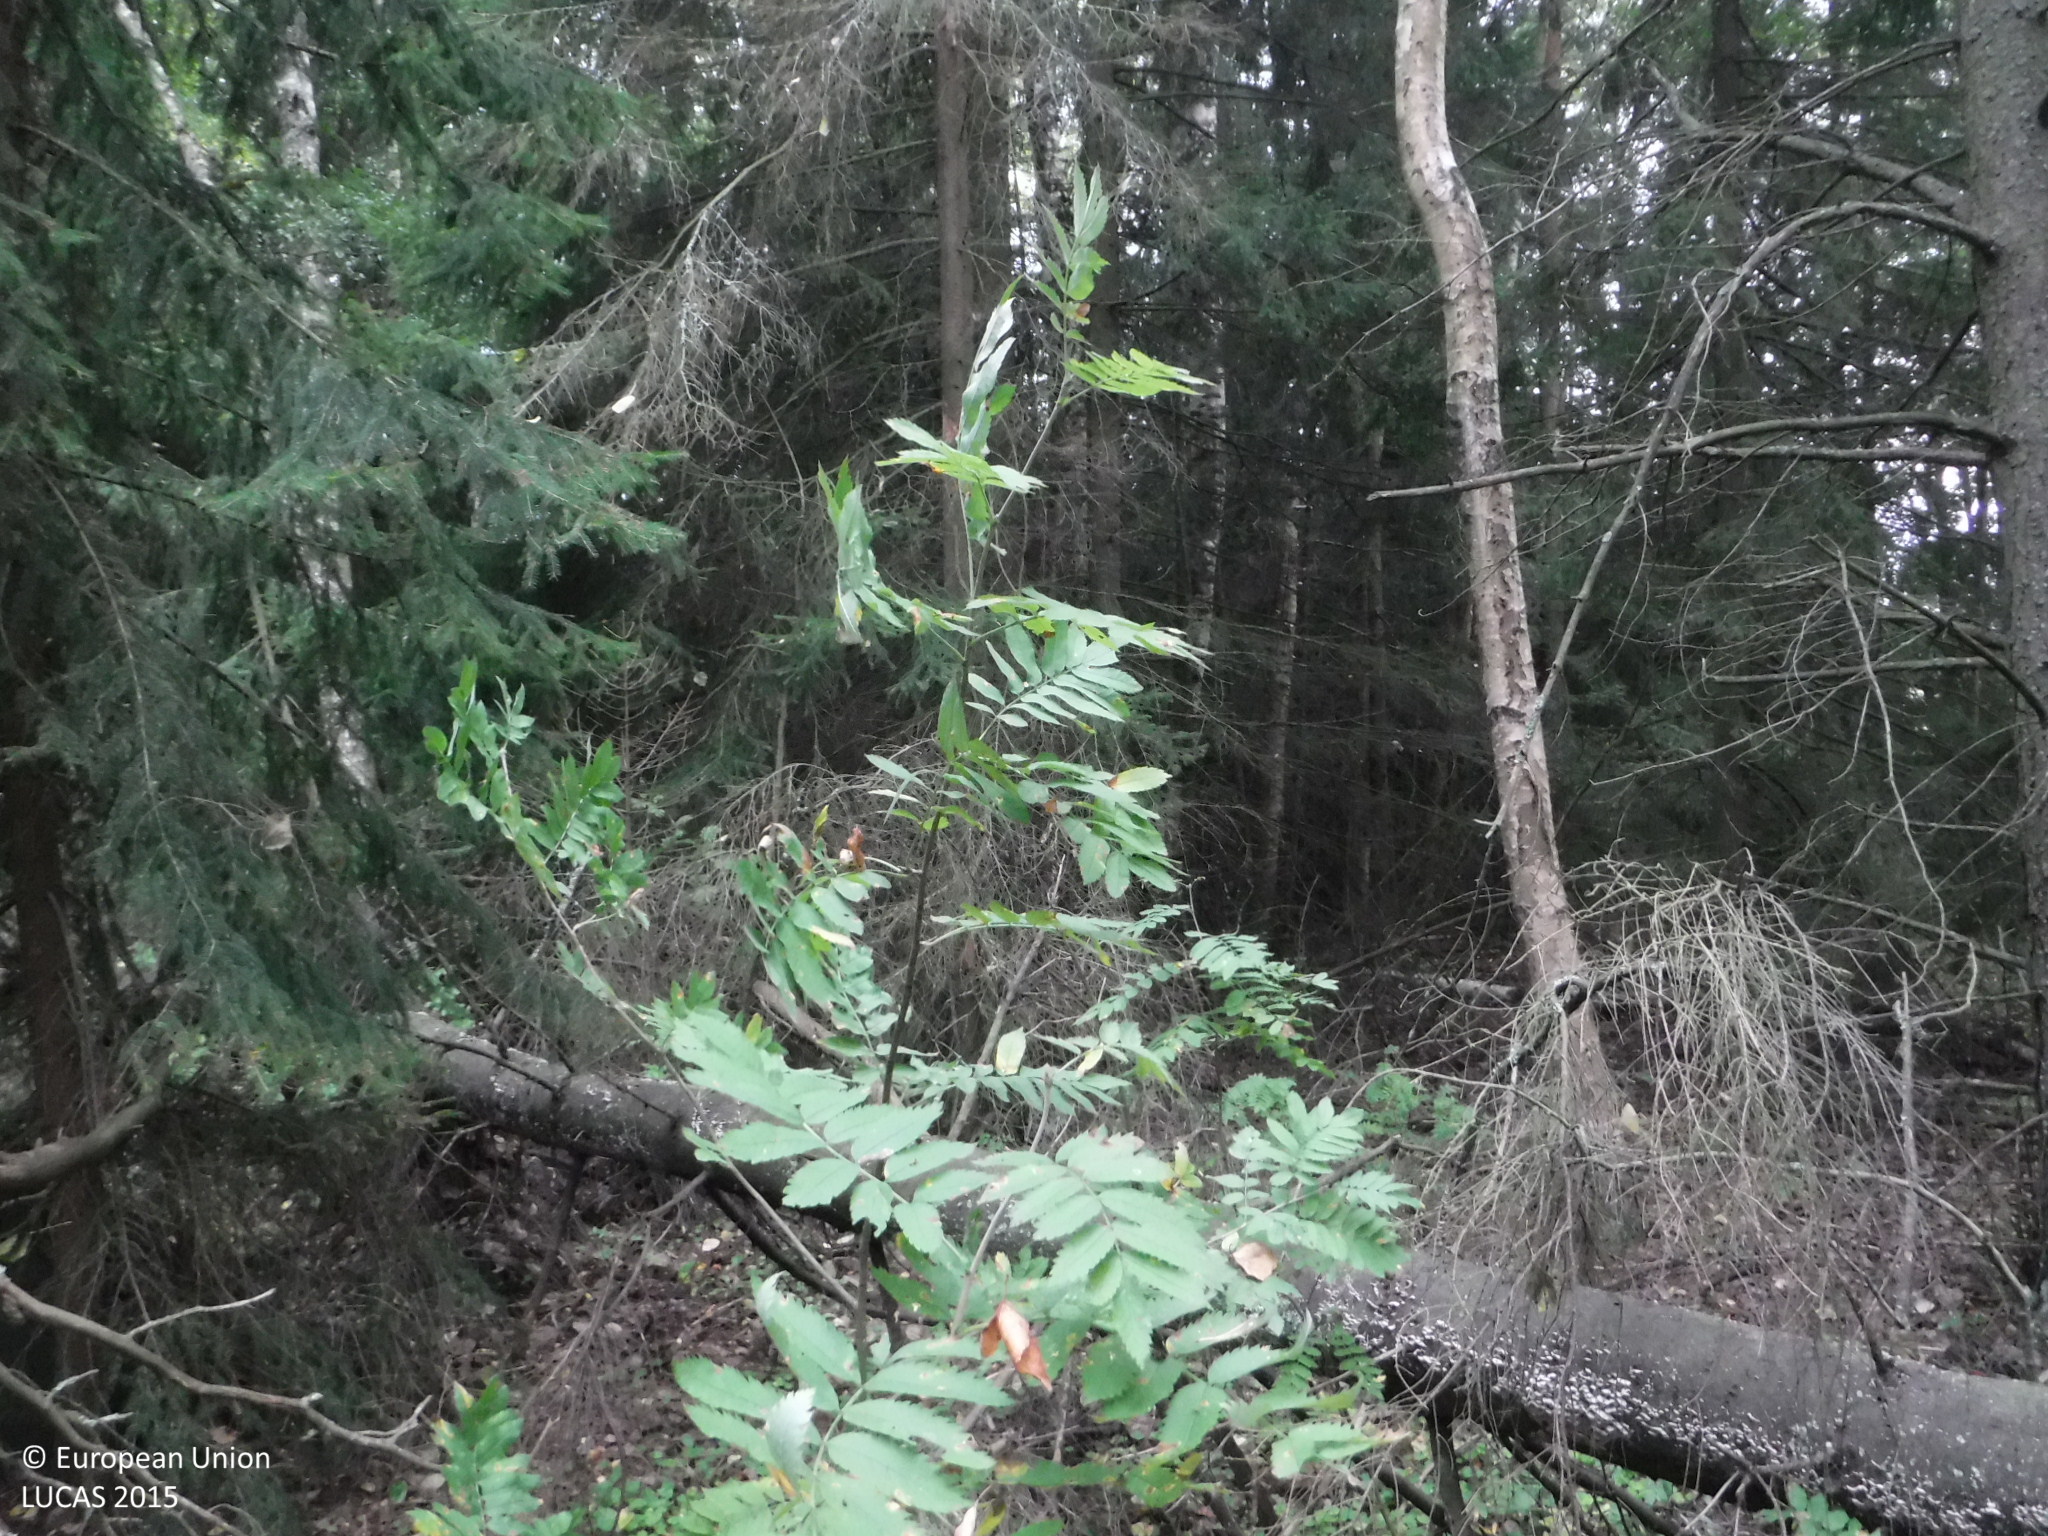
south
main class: Woodland
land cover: Other mixed woodland
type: boreal forest
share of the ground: > 75 %
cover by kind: broadleaved forest trees 40 %, coniferous forest trees 35 %, herbaceous plants 10 %, unconsolidated bare surface 10 %, shrubs 5 %
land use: Semi-natural and natural areas not in use
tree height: > 5 m
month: September
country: FI
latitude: 61.3418
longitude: 22.0397
